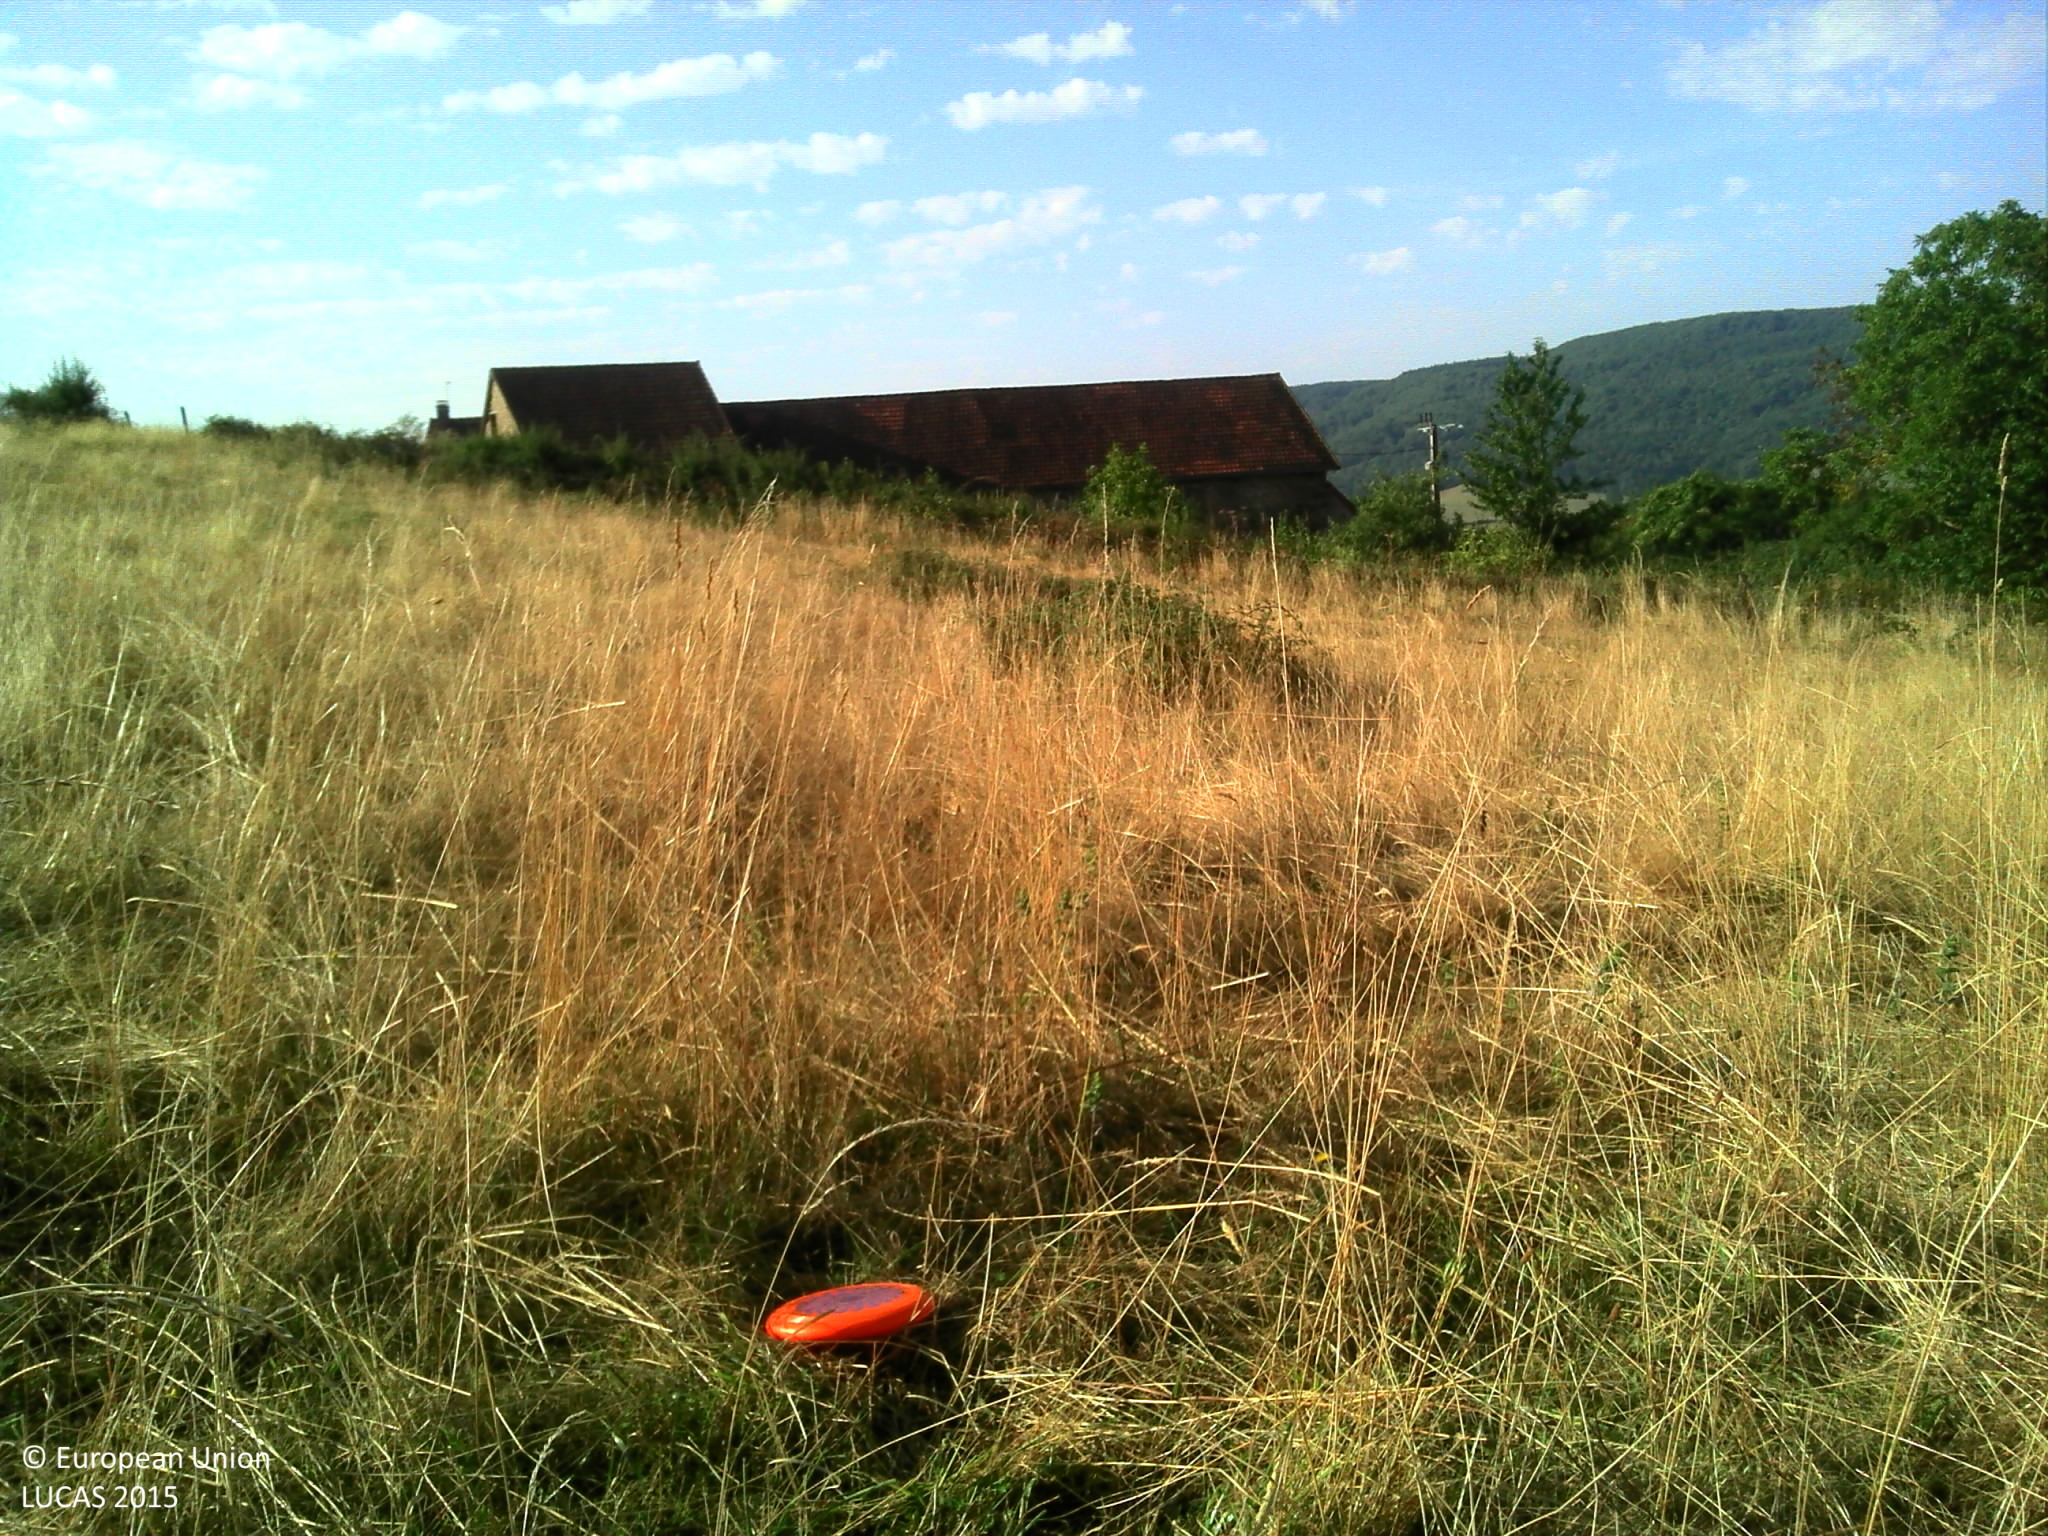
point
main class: Grassland
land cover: Grassland without tree/shrub cover
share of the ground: > 75 %
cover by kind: herbaceous plants 100 %
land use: Agriculture (excluding fallow land and kitchen gardens)
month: August
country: FR
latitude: 46.8516
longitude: 4.3476
